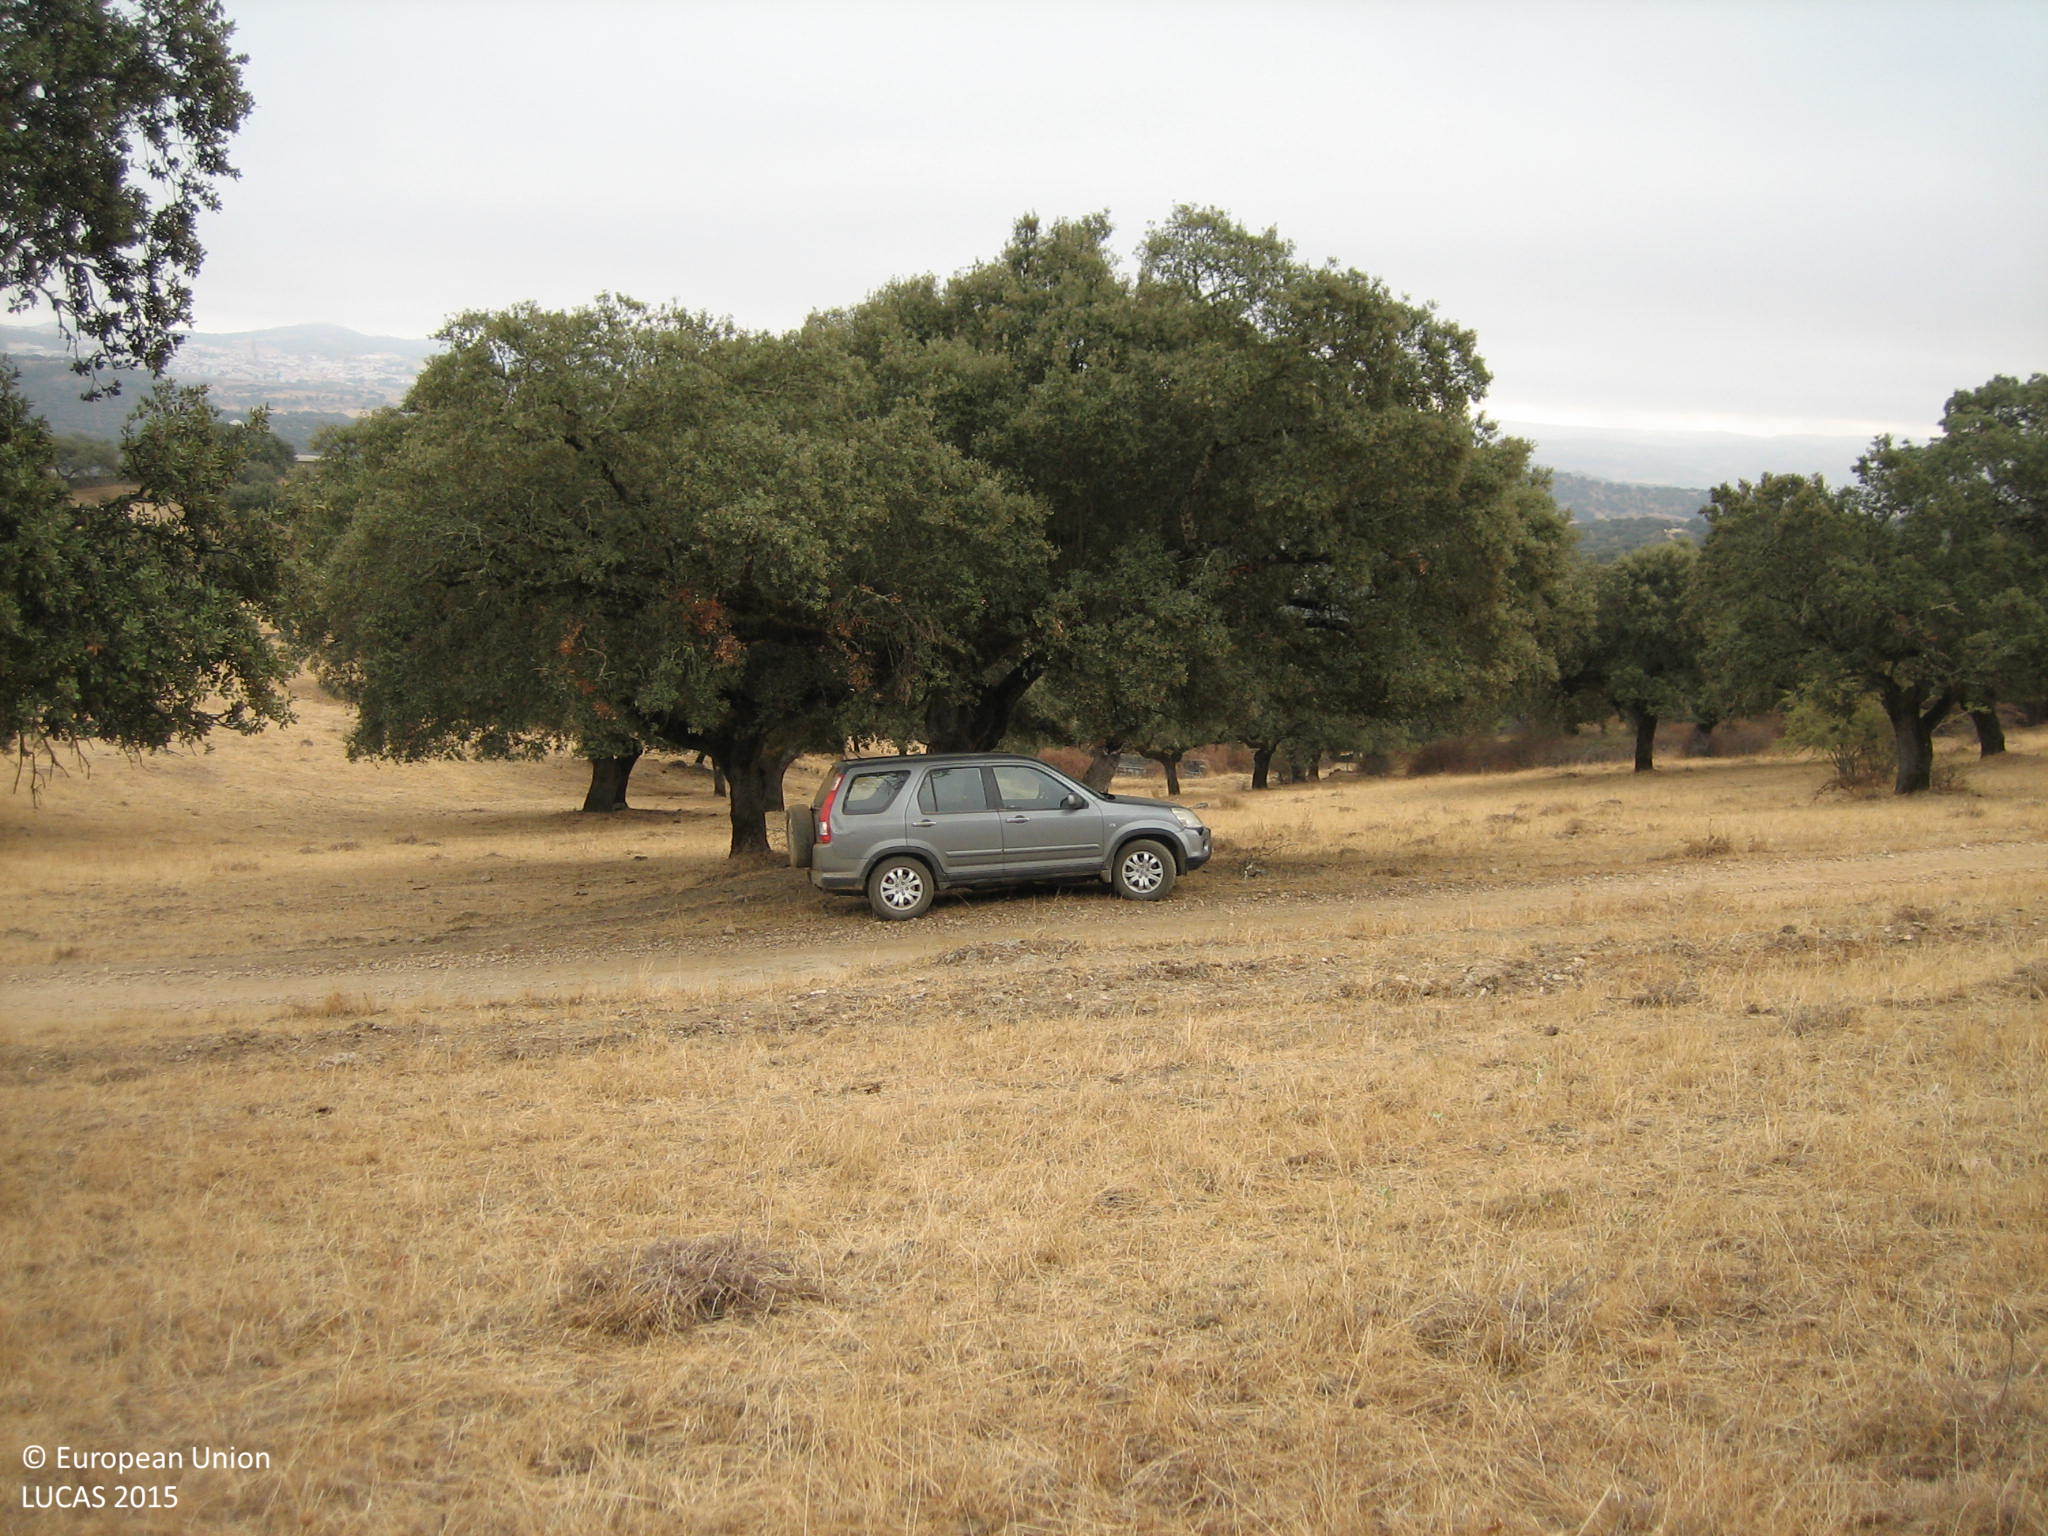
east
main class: Woodland
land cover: Broadleaved woodland
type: broadleaved evergreen forest
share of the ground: 25 - 50 %
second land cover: Grassland without tree/shrub cover
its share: > 75 %
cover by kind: herbaceous plants 60 %, broadleaved forest trees 40 %
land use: Forestry
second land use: Agriculture (excluding fallow land and kitchen gardens)
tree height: > 5 m
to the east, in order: Broadleaved woodland; Grassland without tree/shrub cover; Tracks; Broadleaved woodland; Electric lines; Broadleaved woodland; Electric lines; Broadleaved woodland; Dry stone walls; Other bare soil
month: September
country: ES
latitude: 38.3033
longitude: -6.8319
